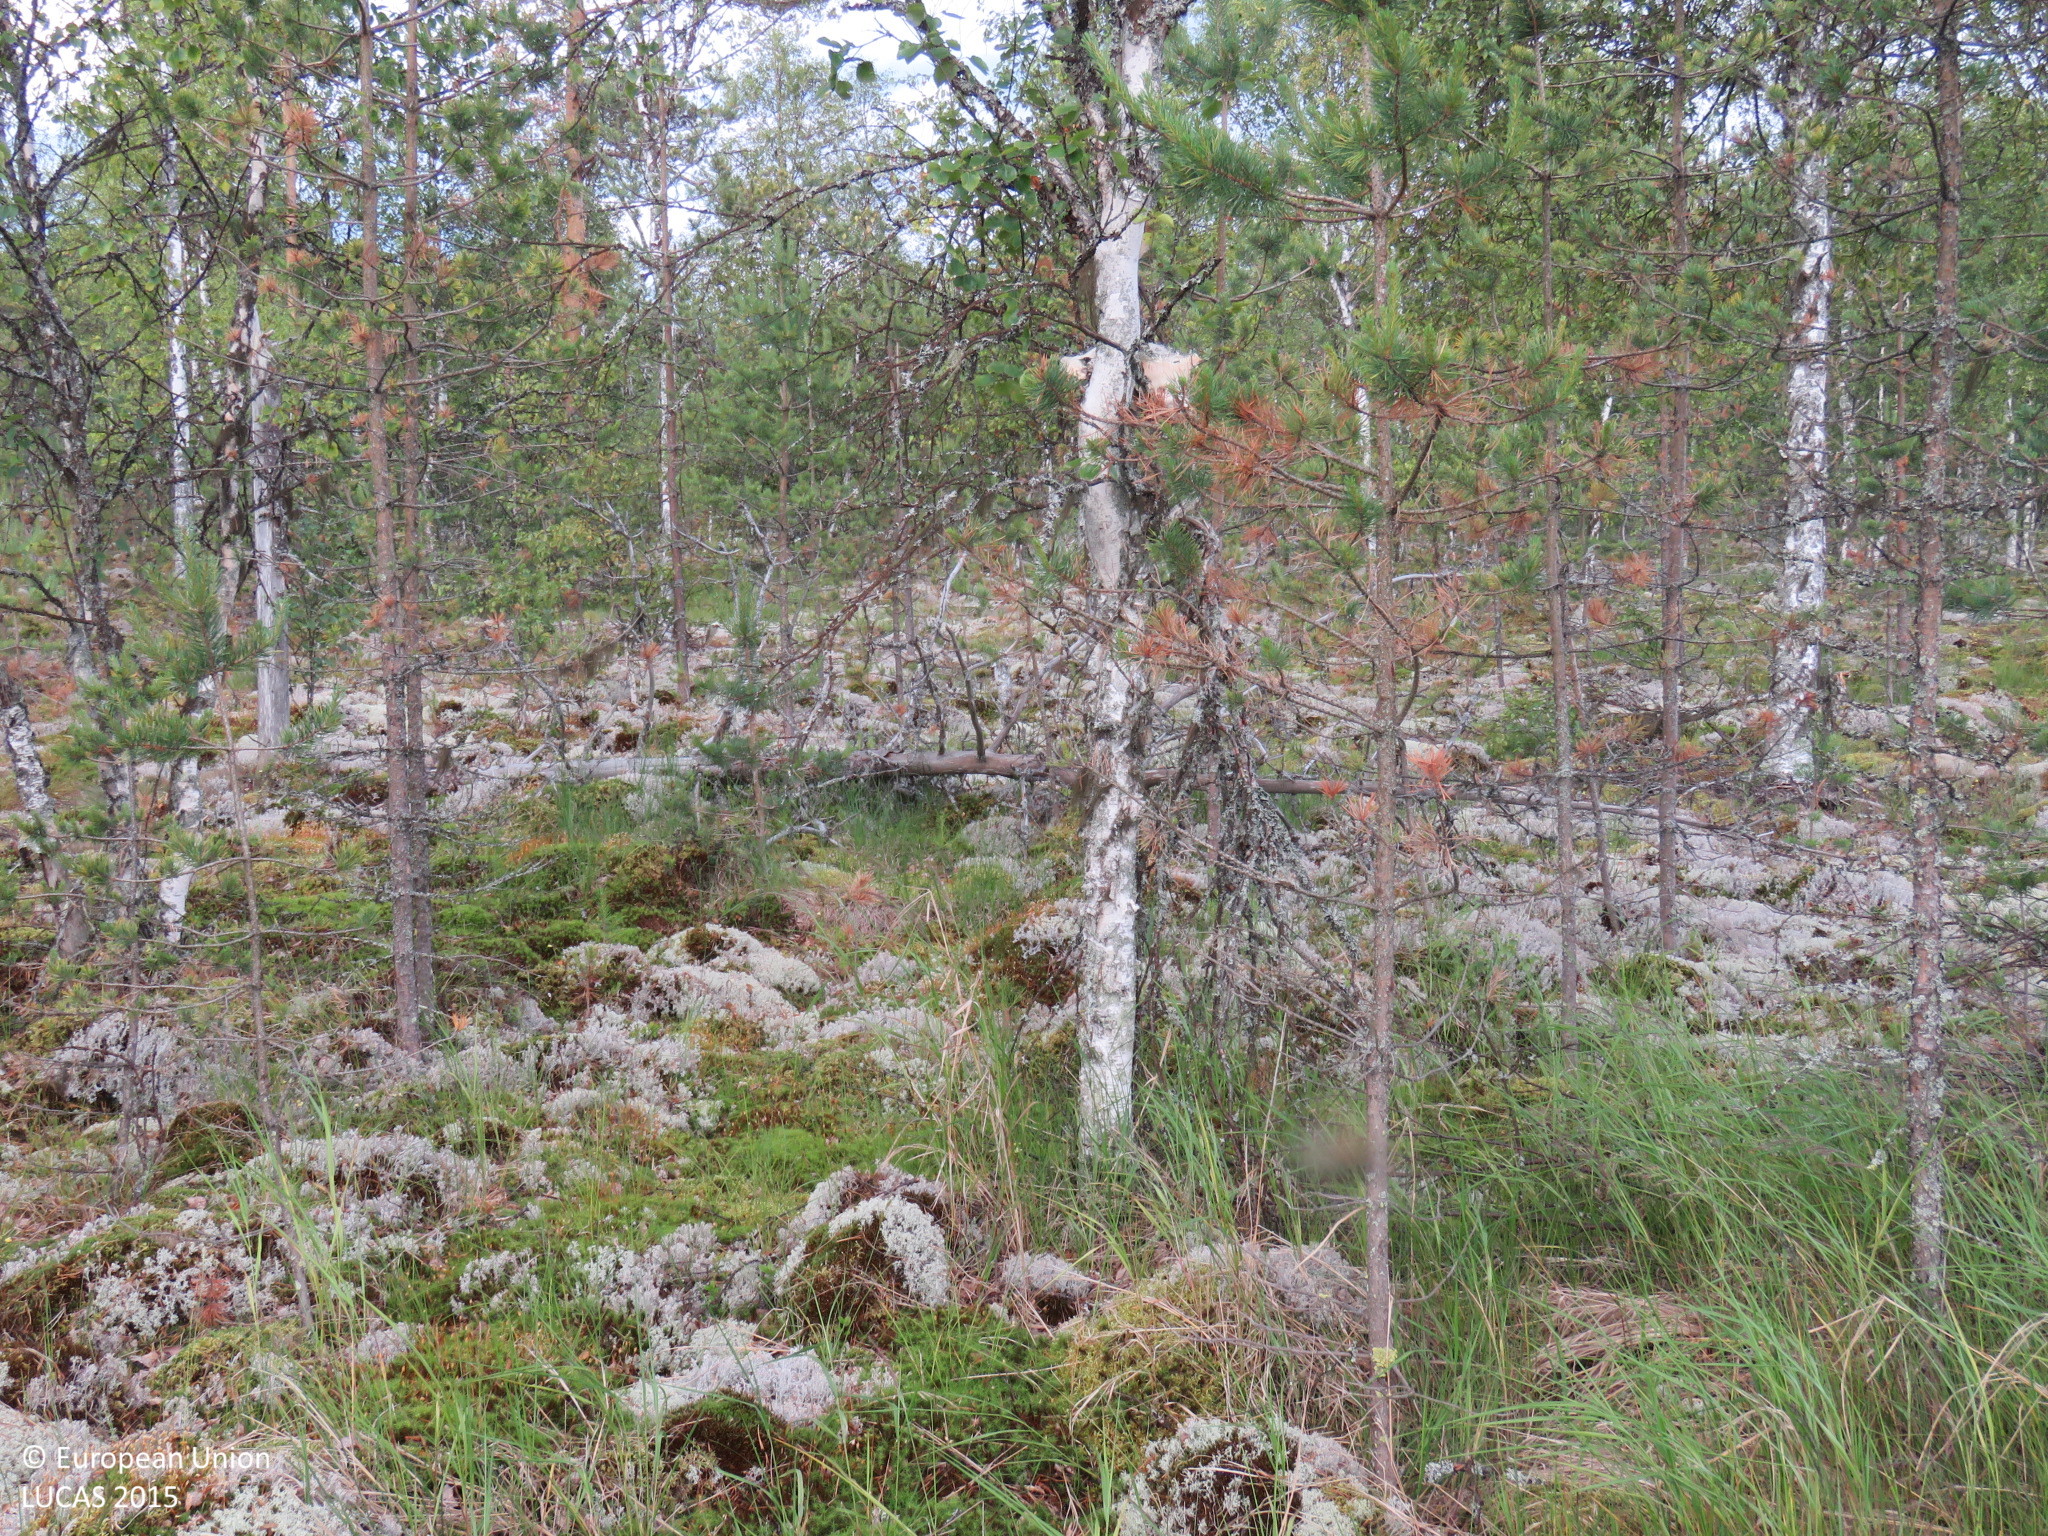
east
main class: Woodland
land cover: Pine dominated mixed woodland
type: mire and swamp forests
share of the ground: 50 - 75 %
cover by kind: coniferous forest trees 35 %, broadleaved forest trees 35 %, lichens and mosses 20 %, herbaceous plants 10 %
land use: Forestry
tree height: > 5 m
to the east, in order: Pine dominated mixed woodland; Spontaneously vegetated surfaces; Broadleaved woodland; Spontaneously vegetated surfaces; Ditches and canals; Spontaneously vegetated surfaces; Ditches and canals; Sand; Spontaneously vegetated surfaces
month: July
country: FI
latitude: 64.5294
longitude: 26.4736
